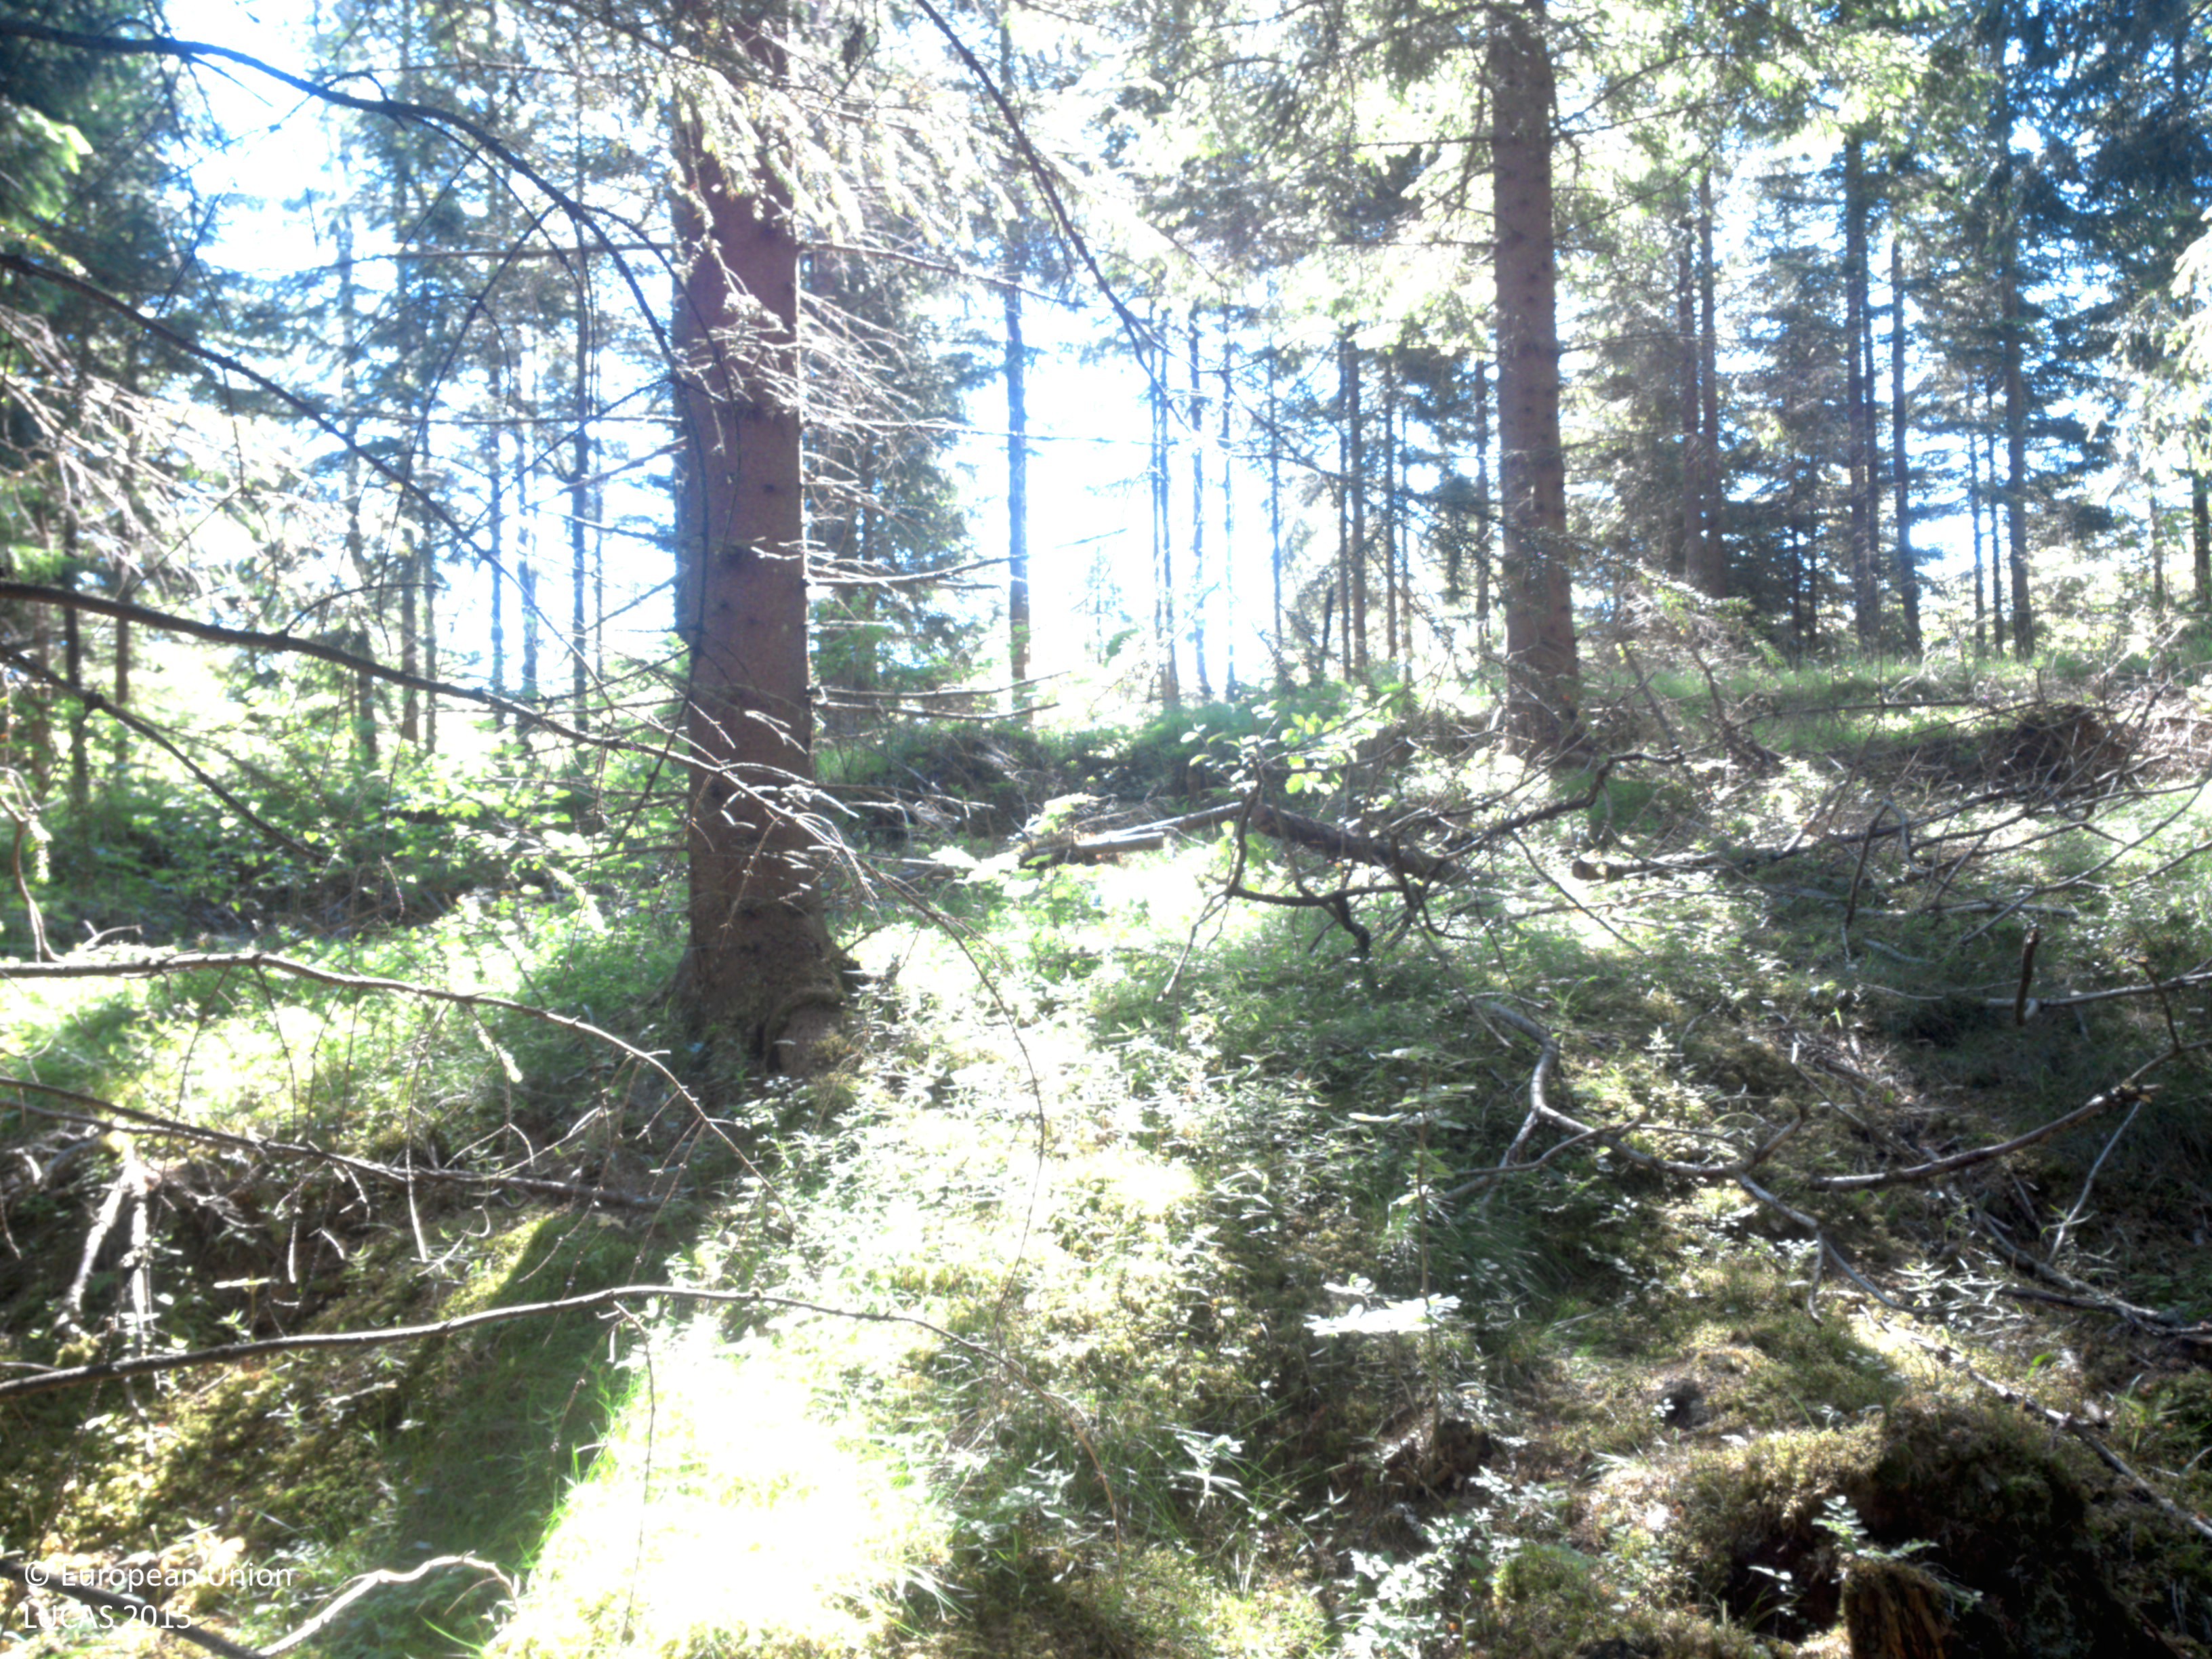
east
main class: Woodland
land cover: Spruce dominated coniferous woodland
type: boreal forest
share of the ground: 50 - 75 %
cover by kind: coniferous forest trees 60 %, lichens and mosses 30 %, shrubs 10 %
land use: Forestry
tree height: > 5 m
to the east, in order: Spruce dominated coniferous woodland; Tracks; Spruce dominated coniferous woodland; Spruce dominated mixed woodland; Tracks; Spruce dominated mixed woodland; Shrubland with sparse tree cover; Spruce dominated mixed woodland; Grassland without tree/shrub cover
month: July
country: SE
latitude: 58.7752
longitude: 12.3298
